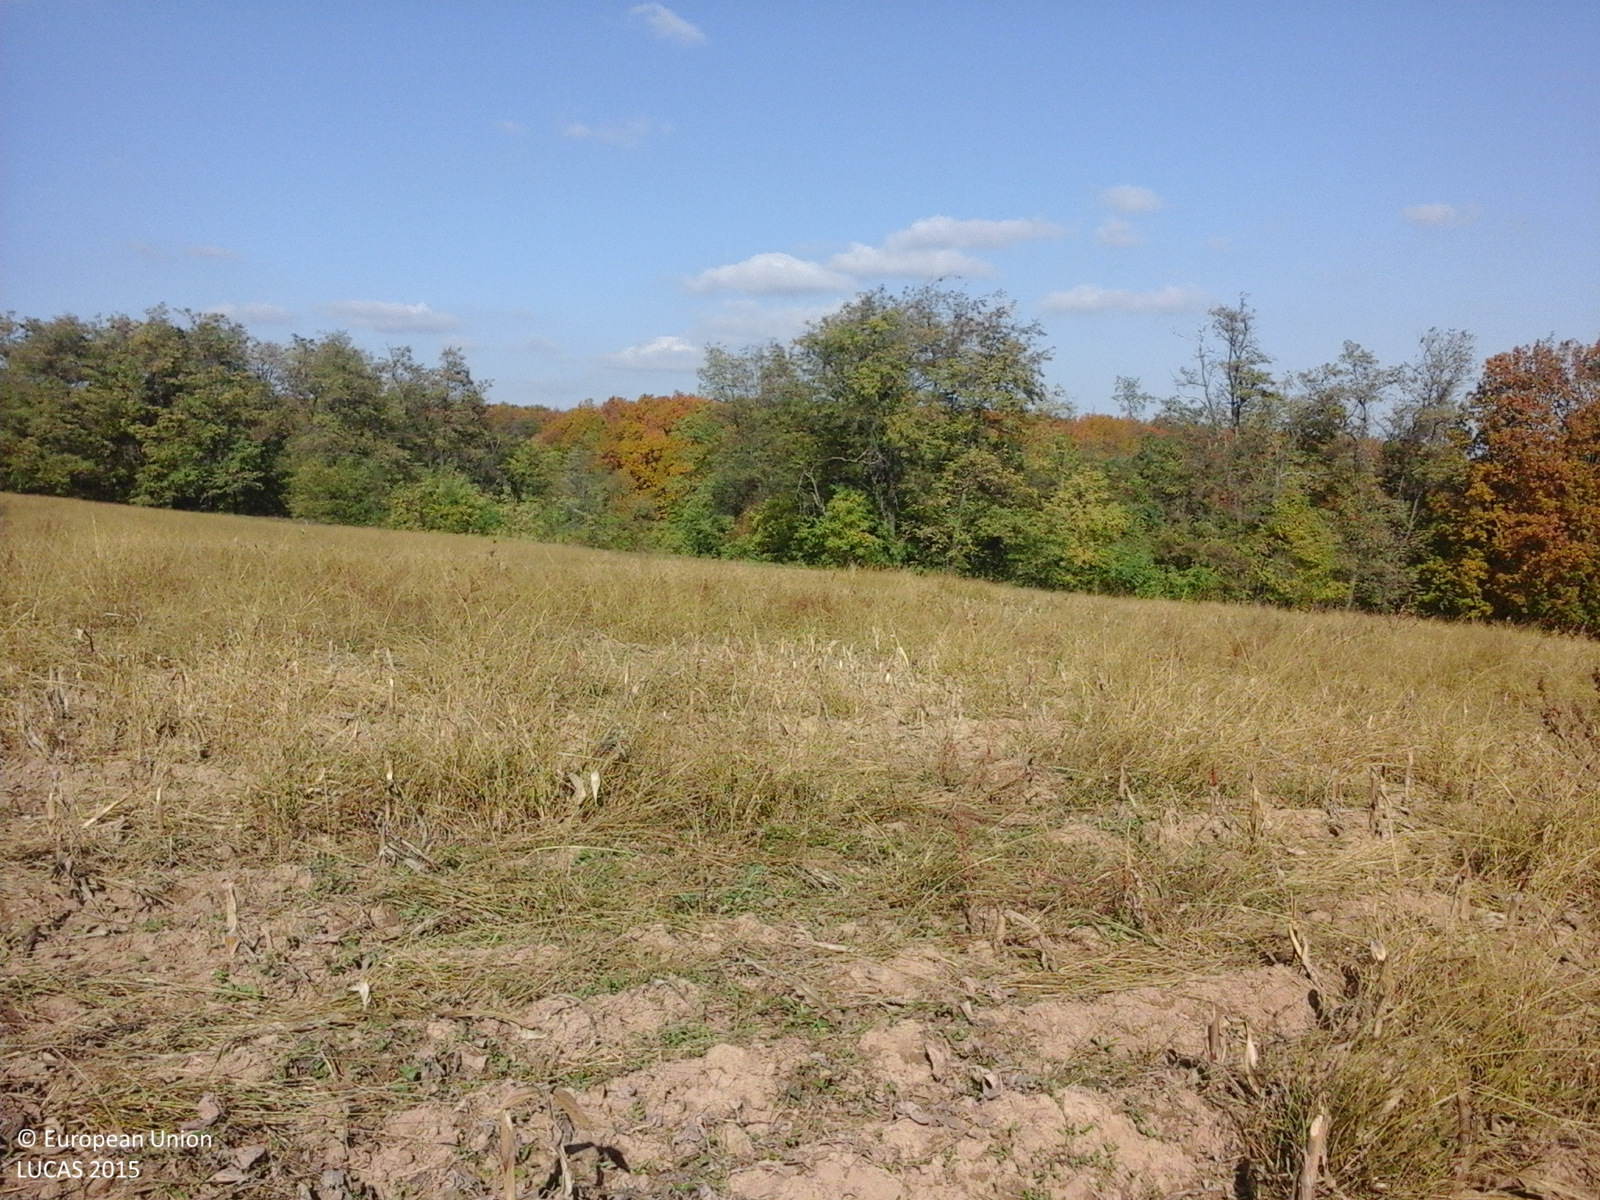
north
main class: Cropland
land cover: Maize
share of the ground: 25 - 50 %
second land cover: Spontaneously vegetated surfaces
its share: > 75 %
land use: Agriculture (excluding fallow land and kitchen gardens)
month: October
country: RO
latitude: 45.9956
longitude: 27.0726
